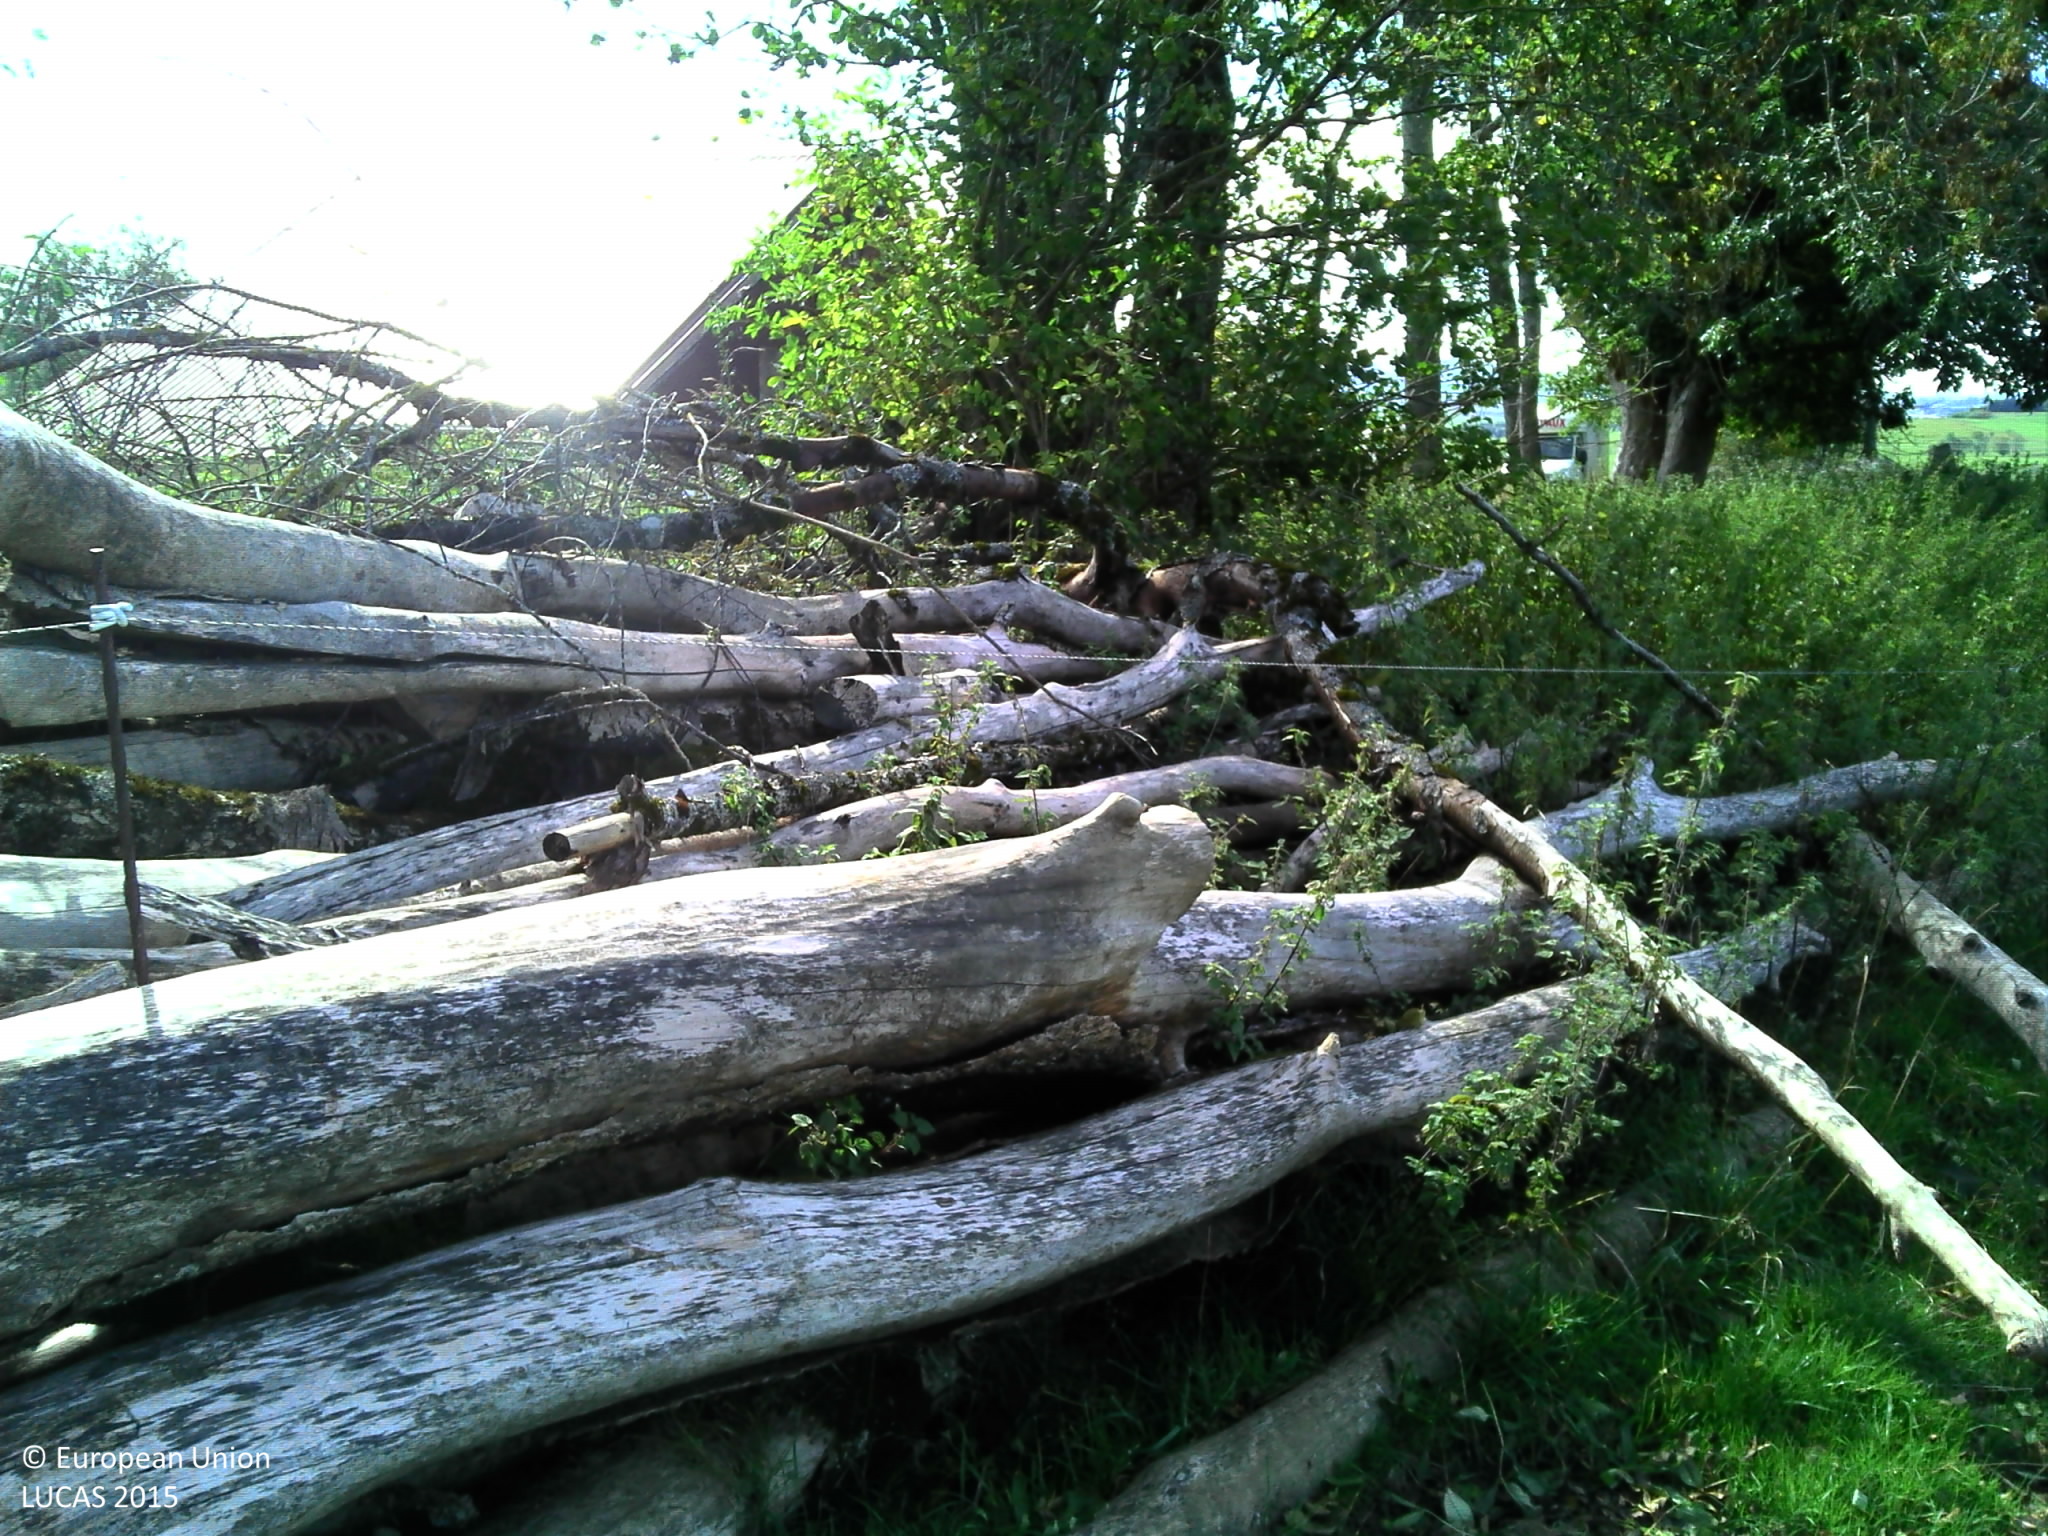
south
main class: Grassland
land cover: Grassland without tree/shrub cover
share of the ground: > 75 %
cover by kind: herbaceous plants 100 %
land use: Agriculture (excluding fallow land and kitchen gardens)
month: October
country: FR
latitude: 46.9564
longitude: 6.3624
